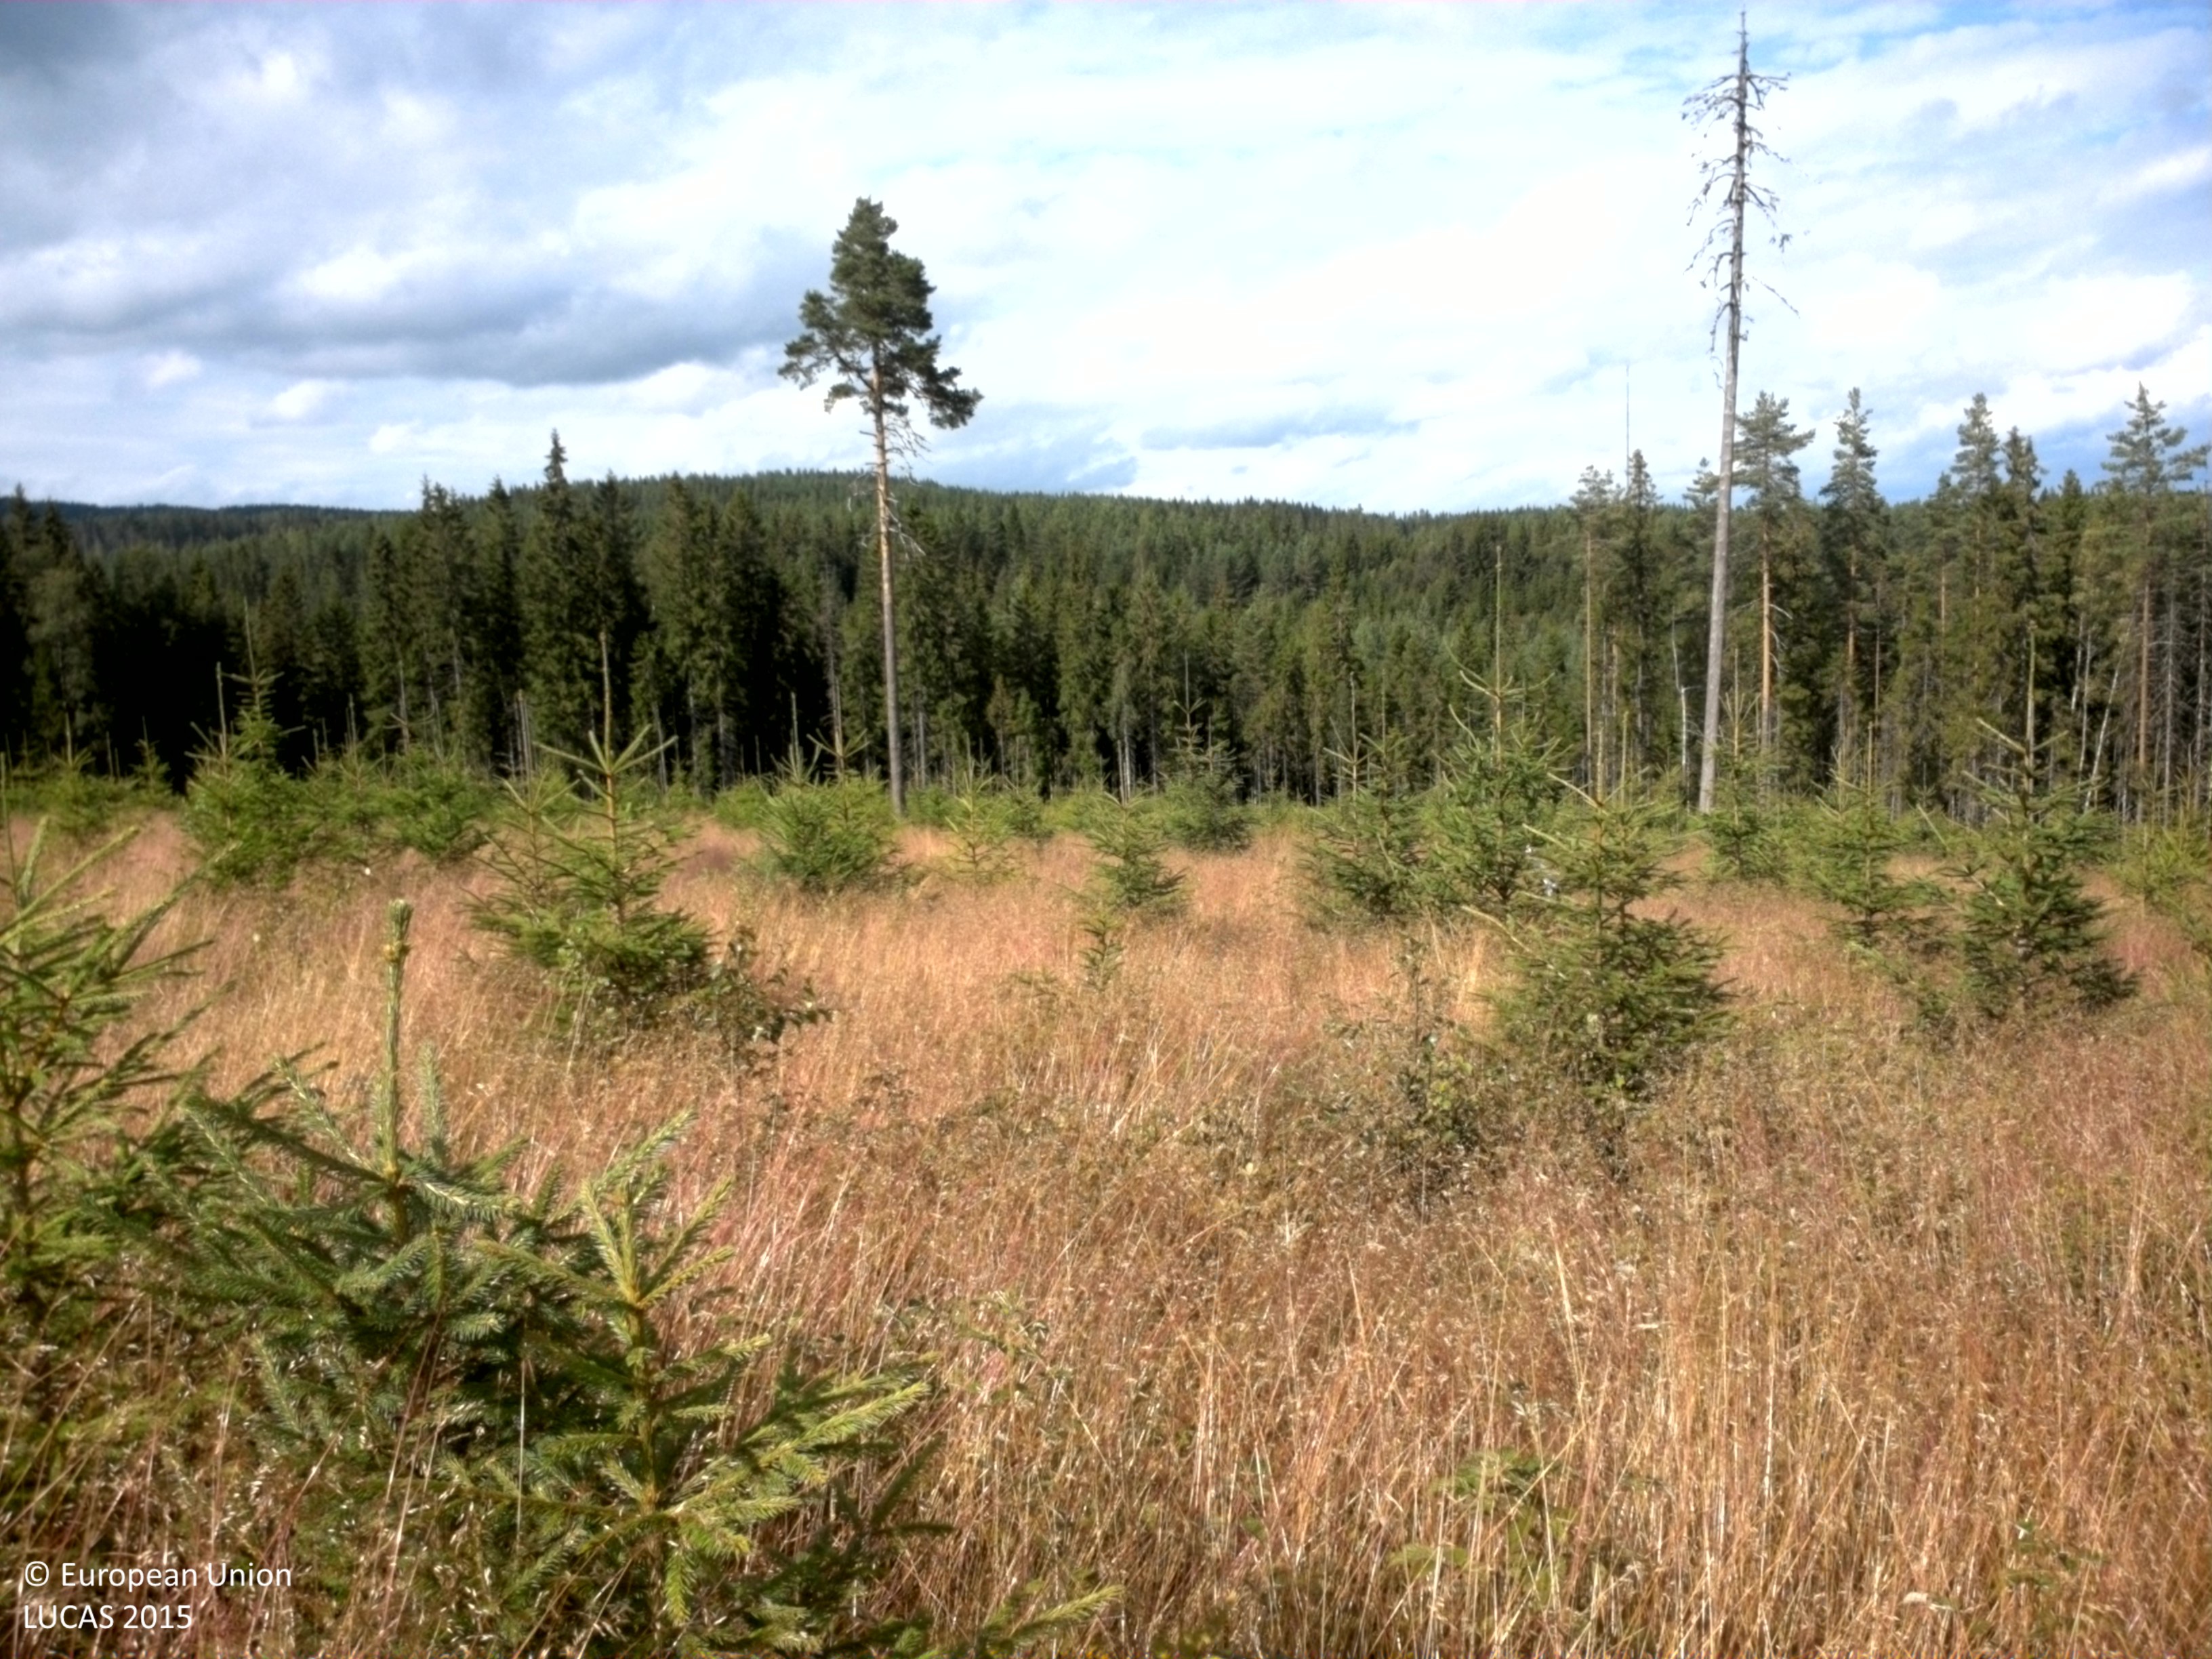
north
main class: Woodland
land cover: Spruce dominated coniferous woodland
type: boreal forest
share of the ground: 10 - 25 %
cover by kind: herbaceous plants 45 %, coniferous forest trees 25 %, shrubs 25 %
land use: Forestry
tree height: < 5 m
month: August
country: SE
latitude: 60.1219
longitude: 13.3921
